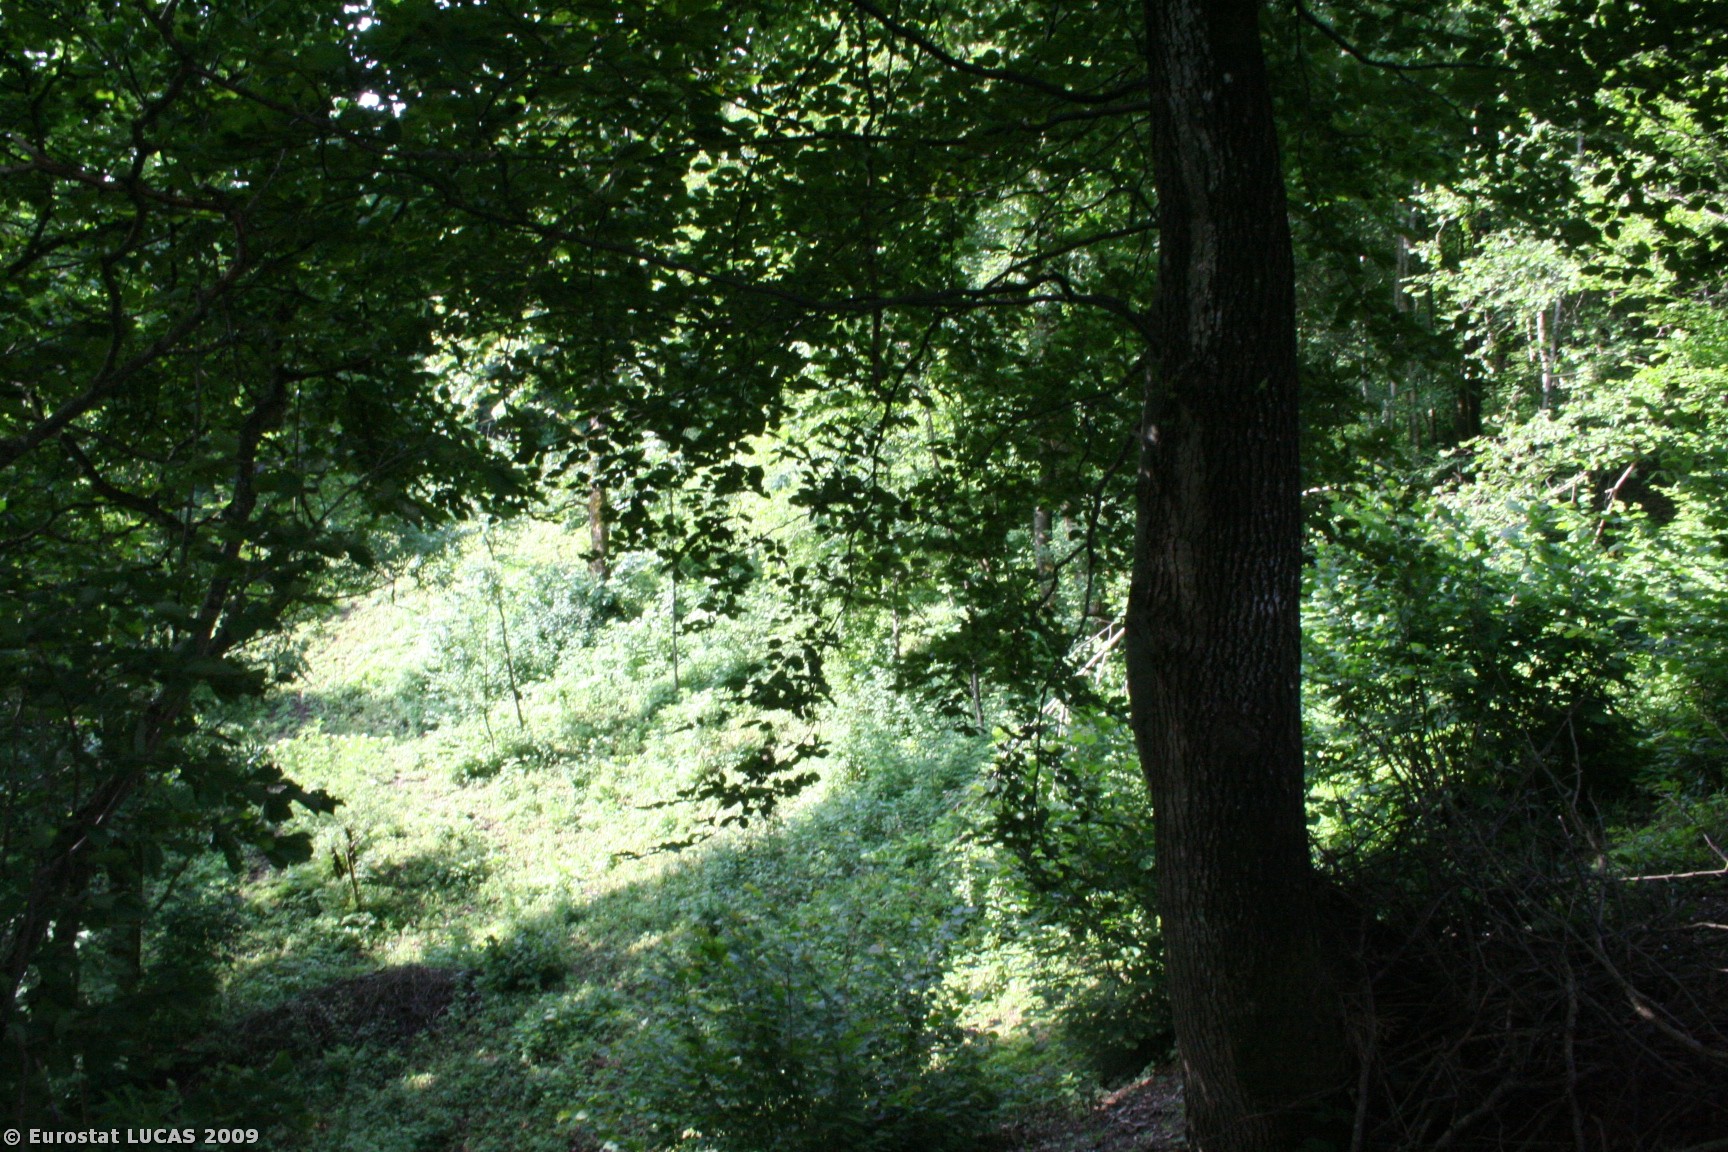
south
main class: Woodland
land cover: Broadleaved woodland
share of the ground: 50 - 75 %
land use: Forestry
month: June
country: AT
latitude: 47.4568
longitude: 13.1950
